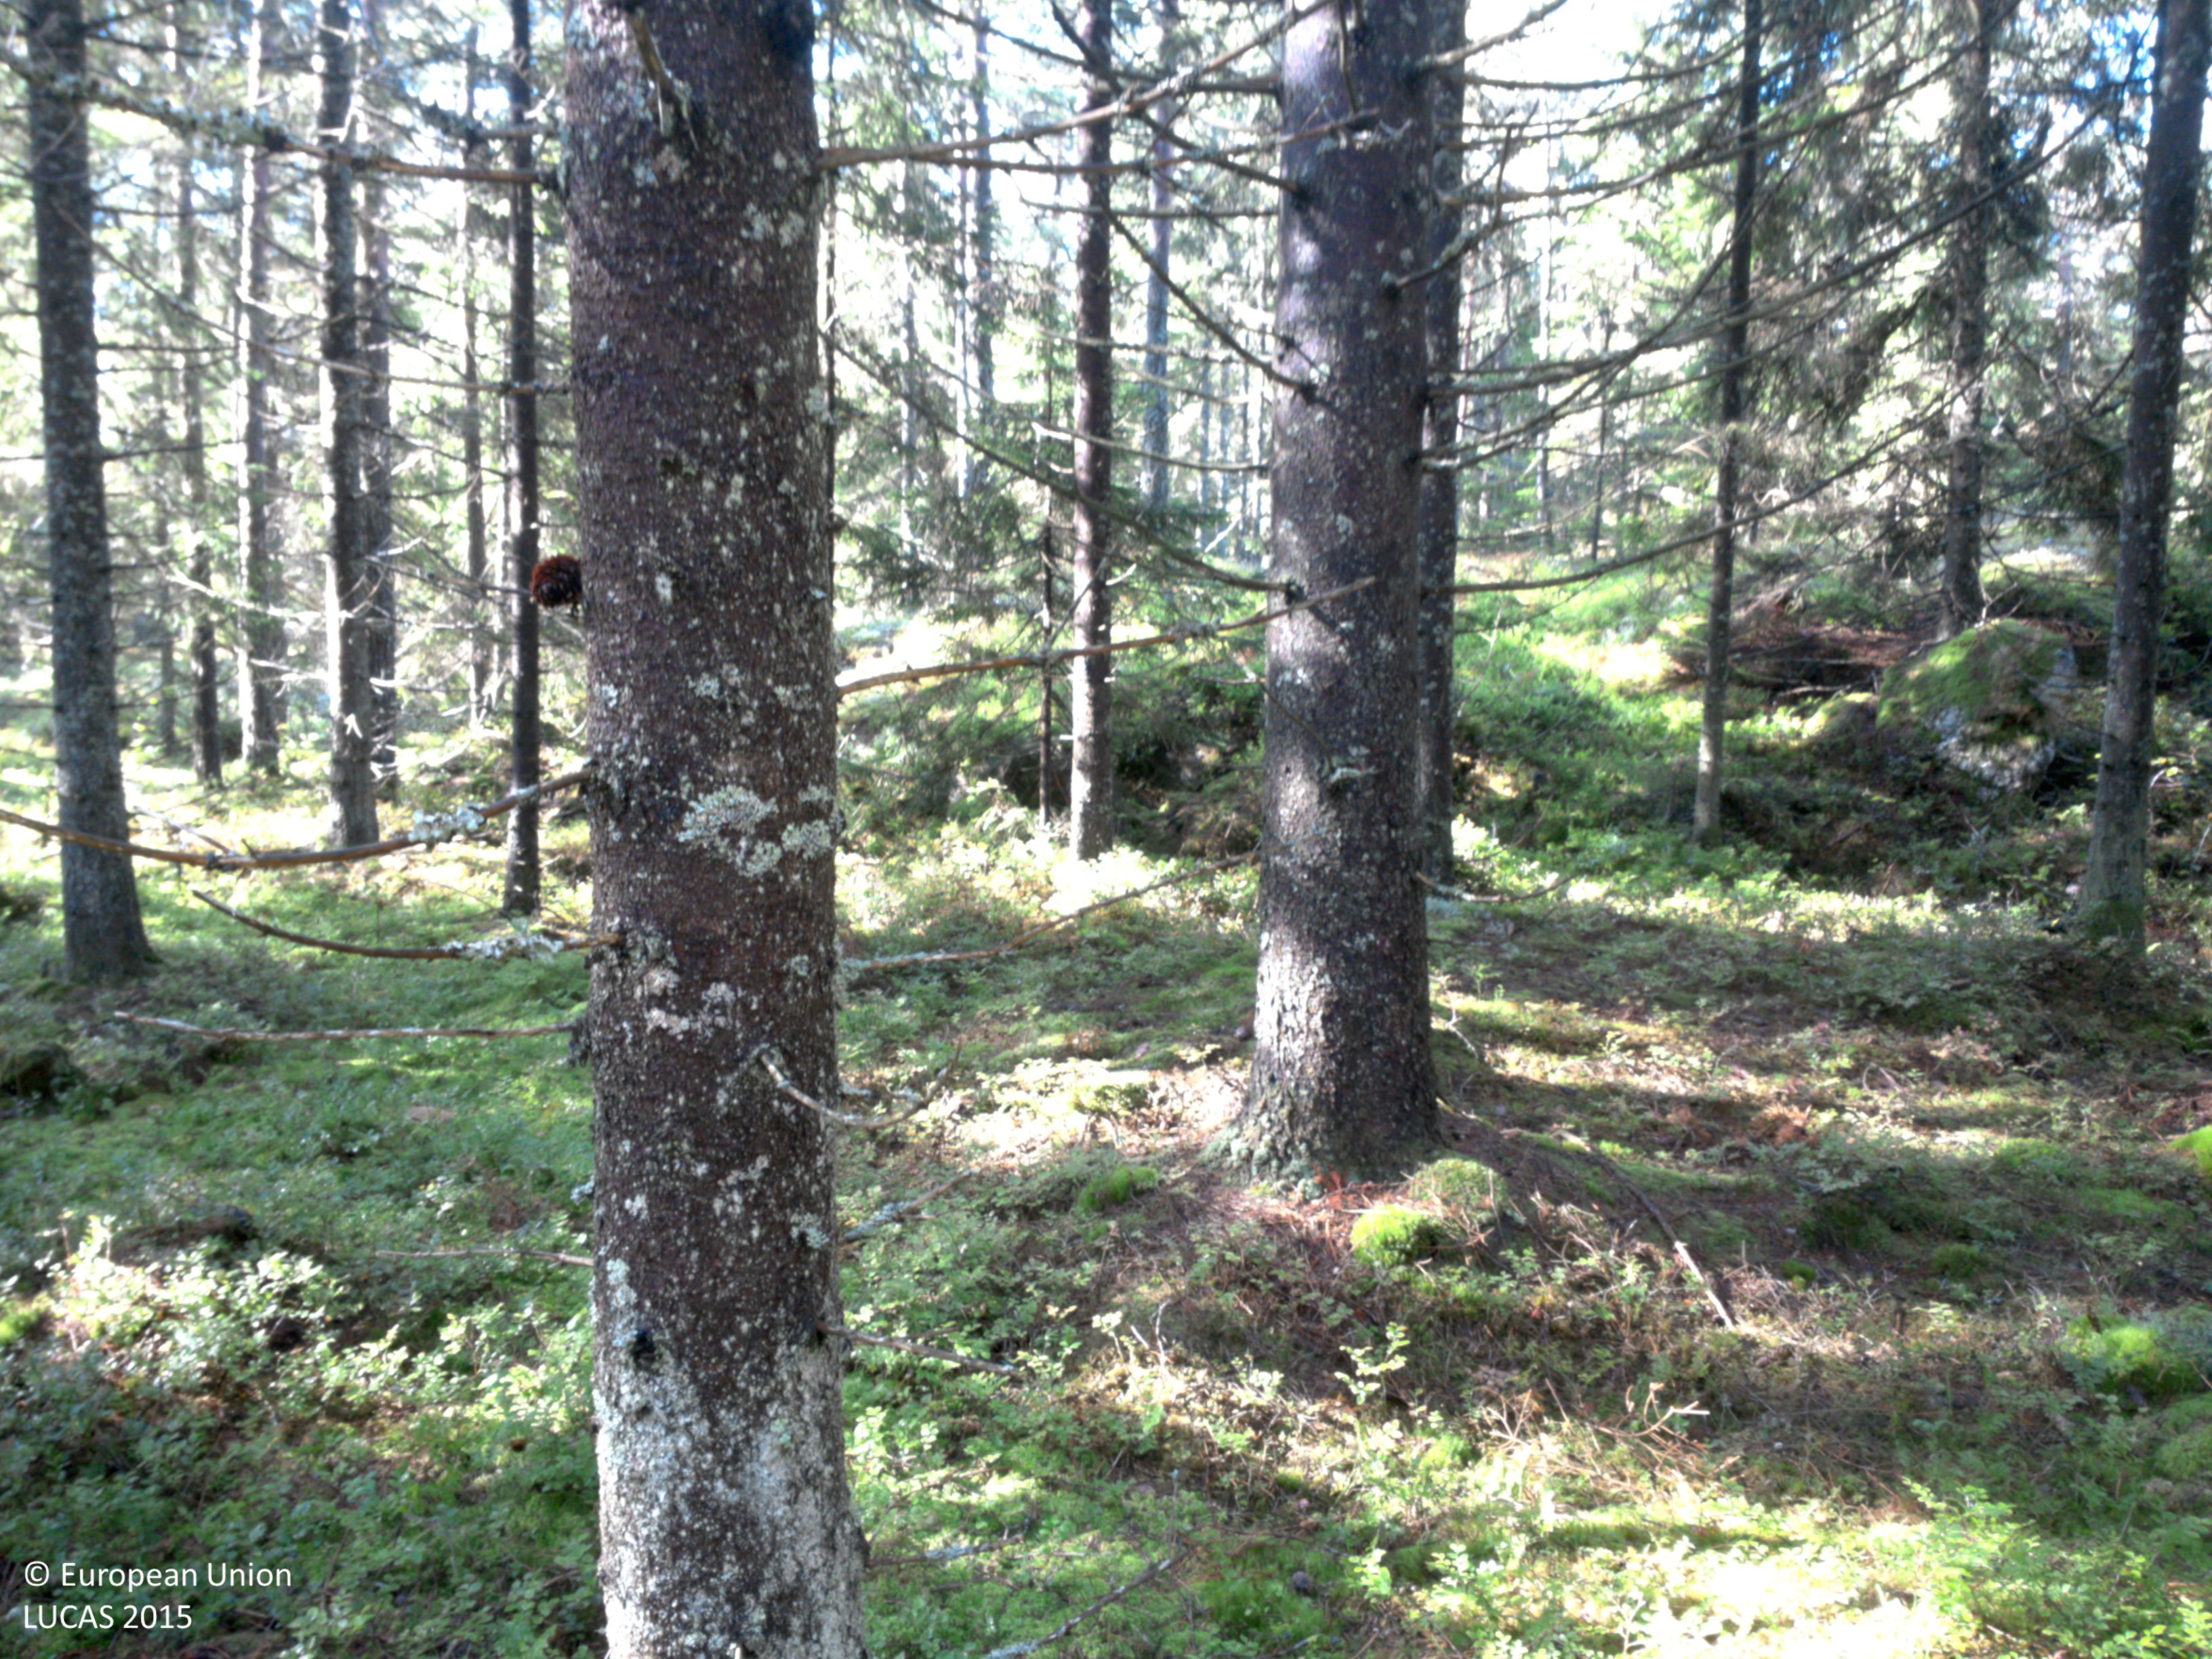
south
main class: Woodland
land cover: Spruce dominated coniferous woodland
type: boreal forest
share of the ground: 50 - 75 %
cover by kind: coniferous forest trees 60 %, lichens and mosses 25 %, shrubs 15 %
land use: Forestry
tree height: > 5 m
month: August
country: SE
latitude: 58.3089
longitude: 12.2314
